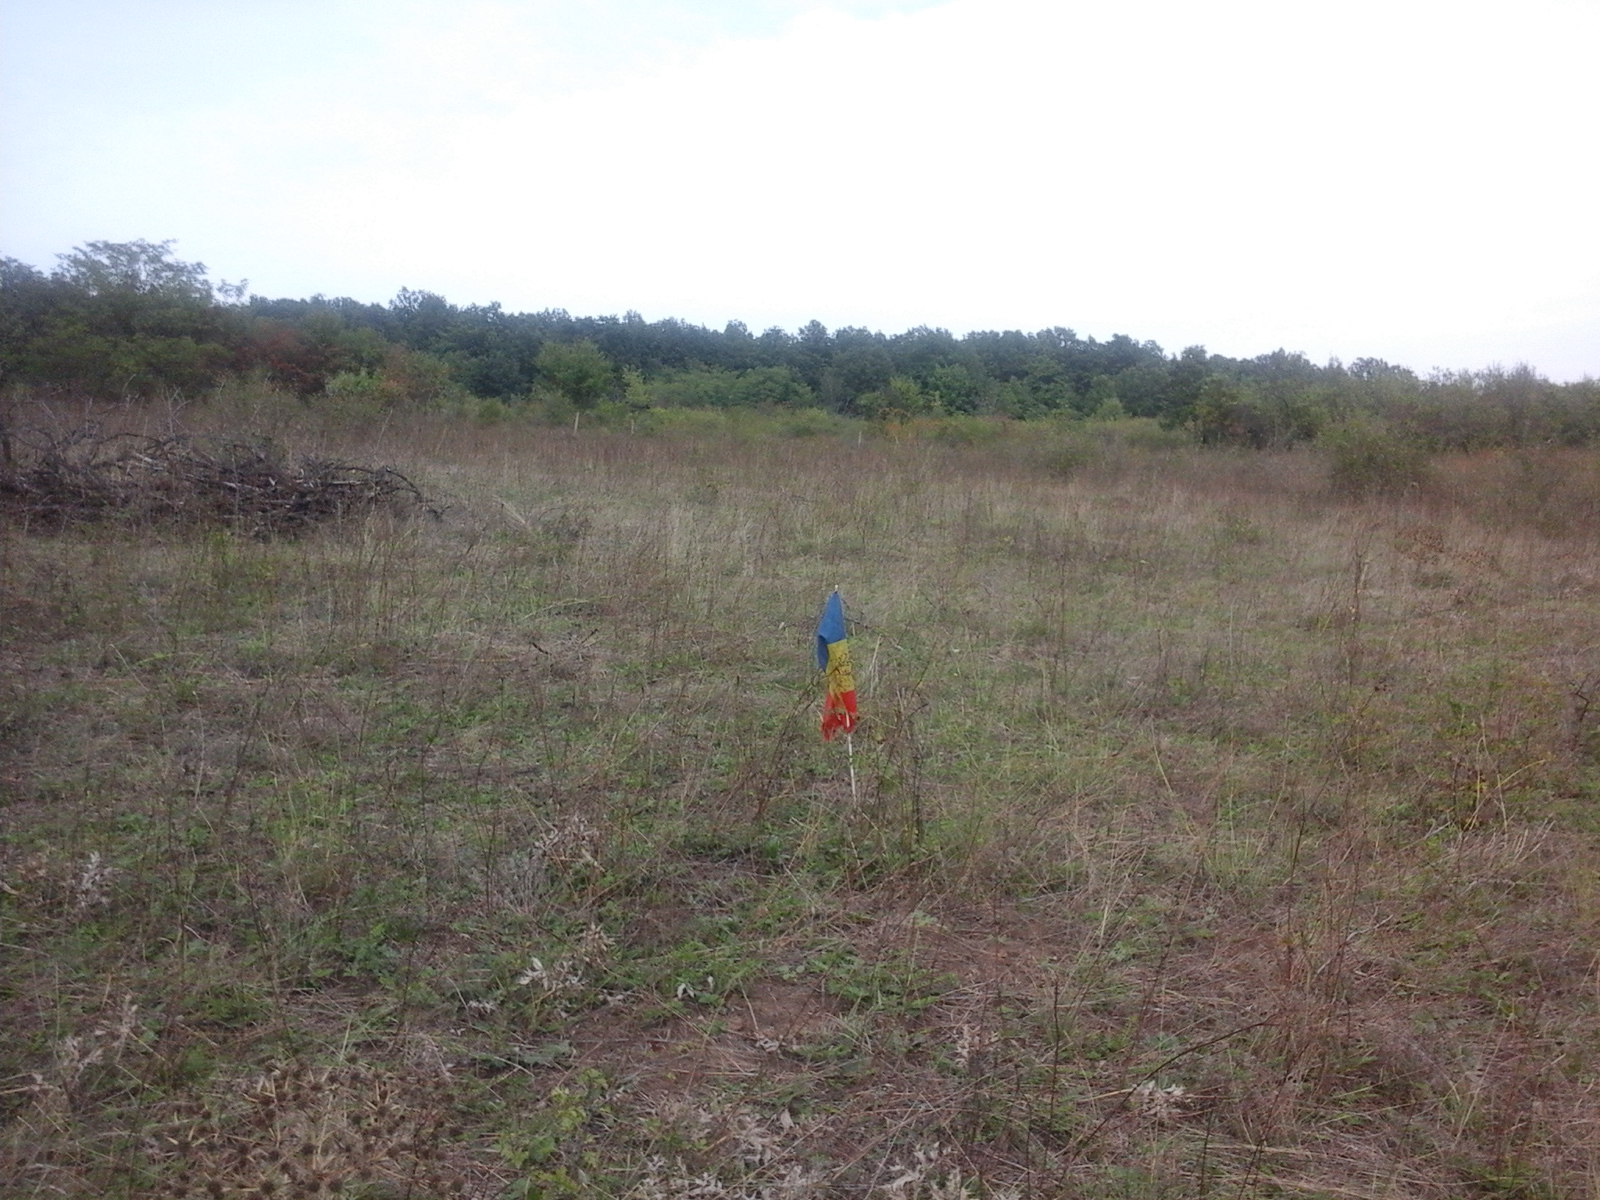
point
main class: Cropland
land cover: Other fruit trees and berries
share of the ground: > 75 %
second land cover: Grassland without tree/shrub cover
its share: > 75 %
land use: Agriculture (excluding fallow land and kitchen gardens)
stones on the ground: < 10 %
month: September
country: RO
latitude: 45.7576
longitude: 22.9749
